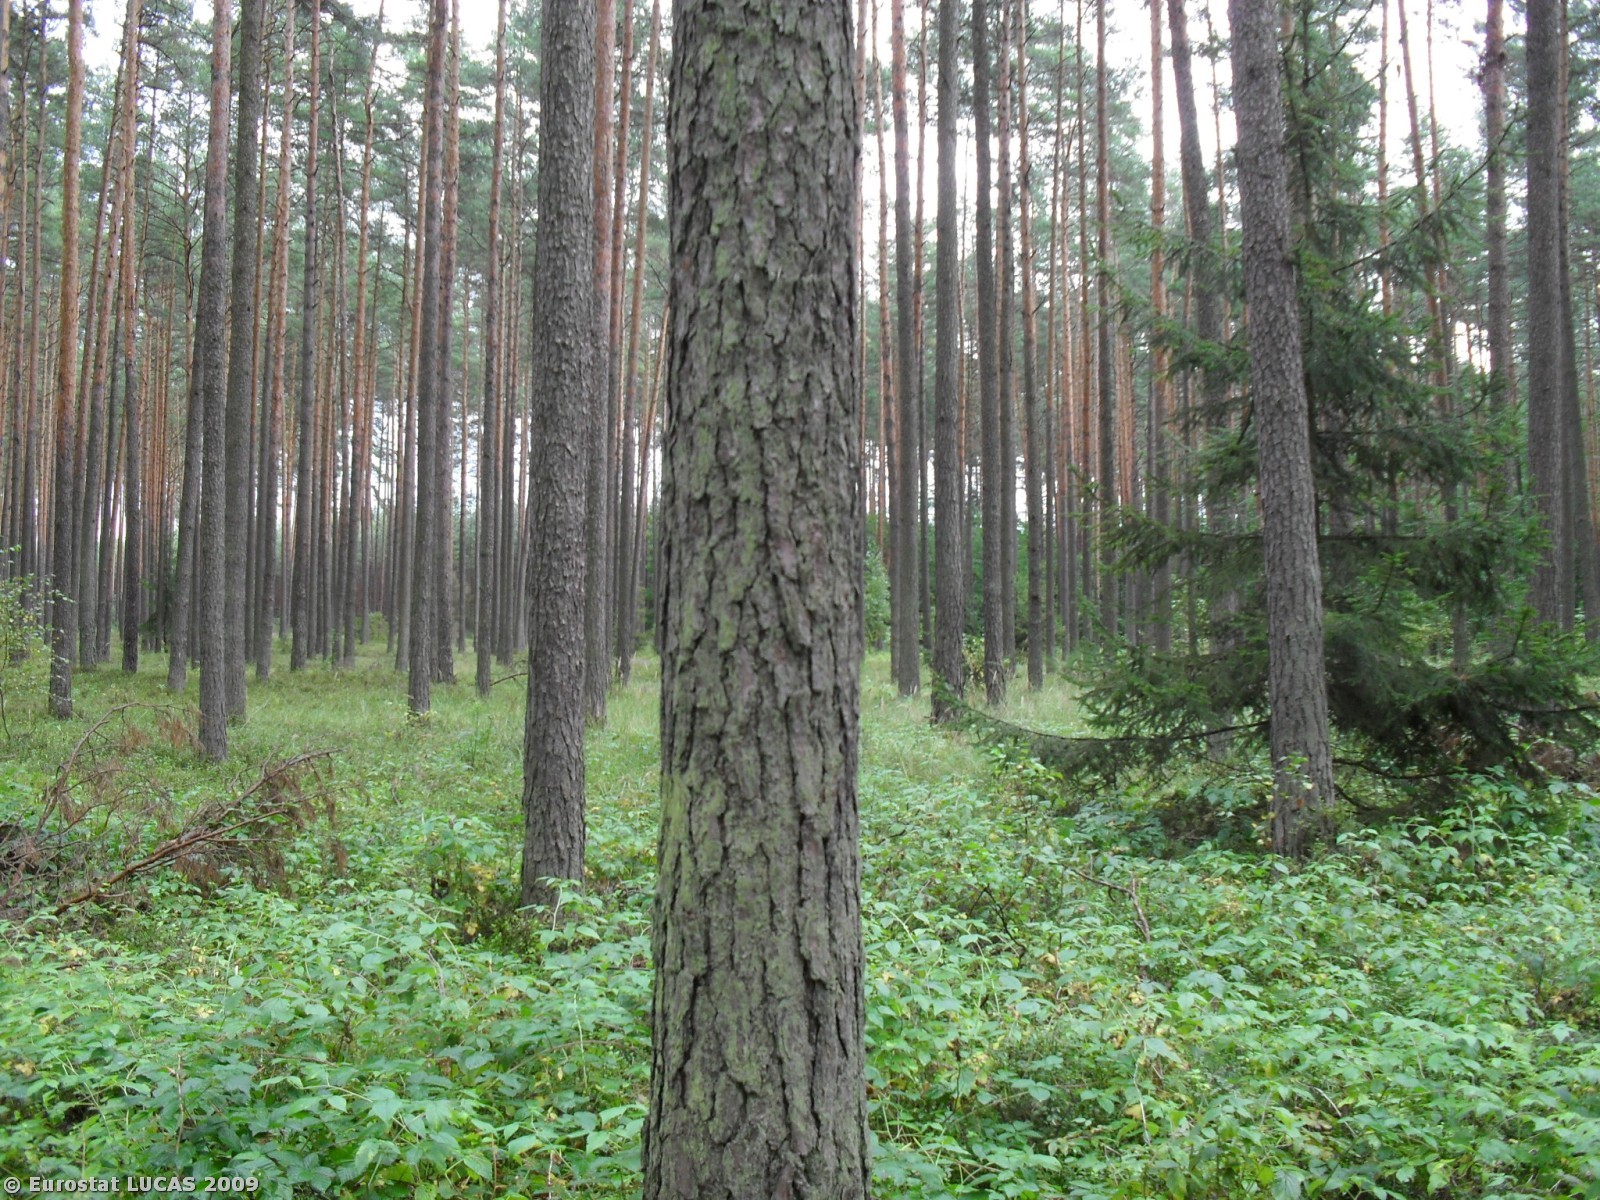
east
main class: Woodland
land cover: Coniferous woodland
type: hemiboreal forest and nemoral coniferous forest and mixed broadleaved-coniferous forest
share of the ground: > 75 %
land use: Forestry
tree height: > 5 m
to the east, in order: Coniferous woodland; Tracks; Coniferous woodland; Tracks; Coniferous woodland
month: September
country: PL
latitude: 50.7781
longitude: 17.8861
